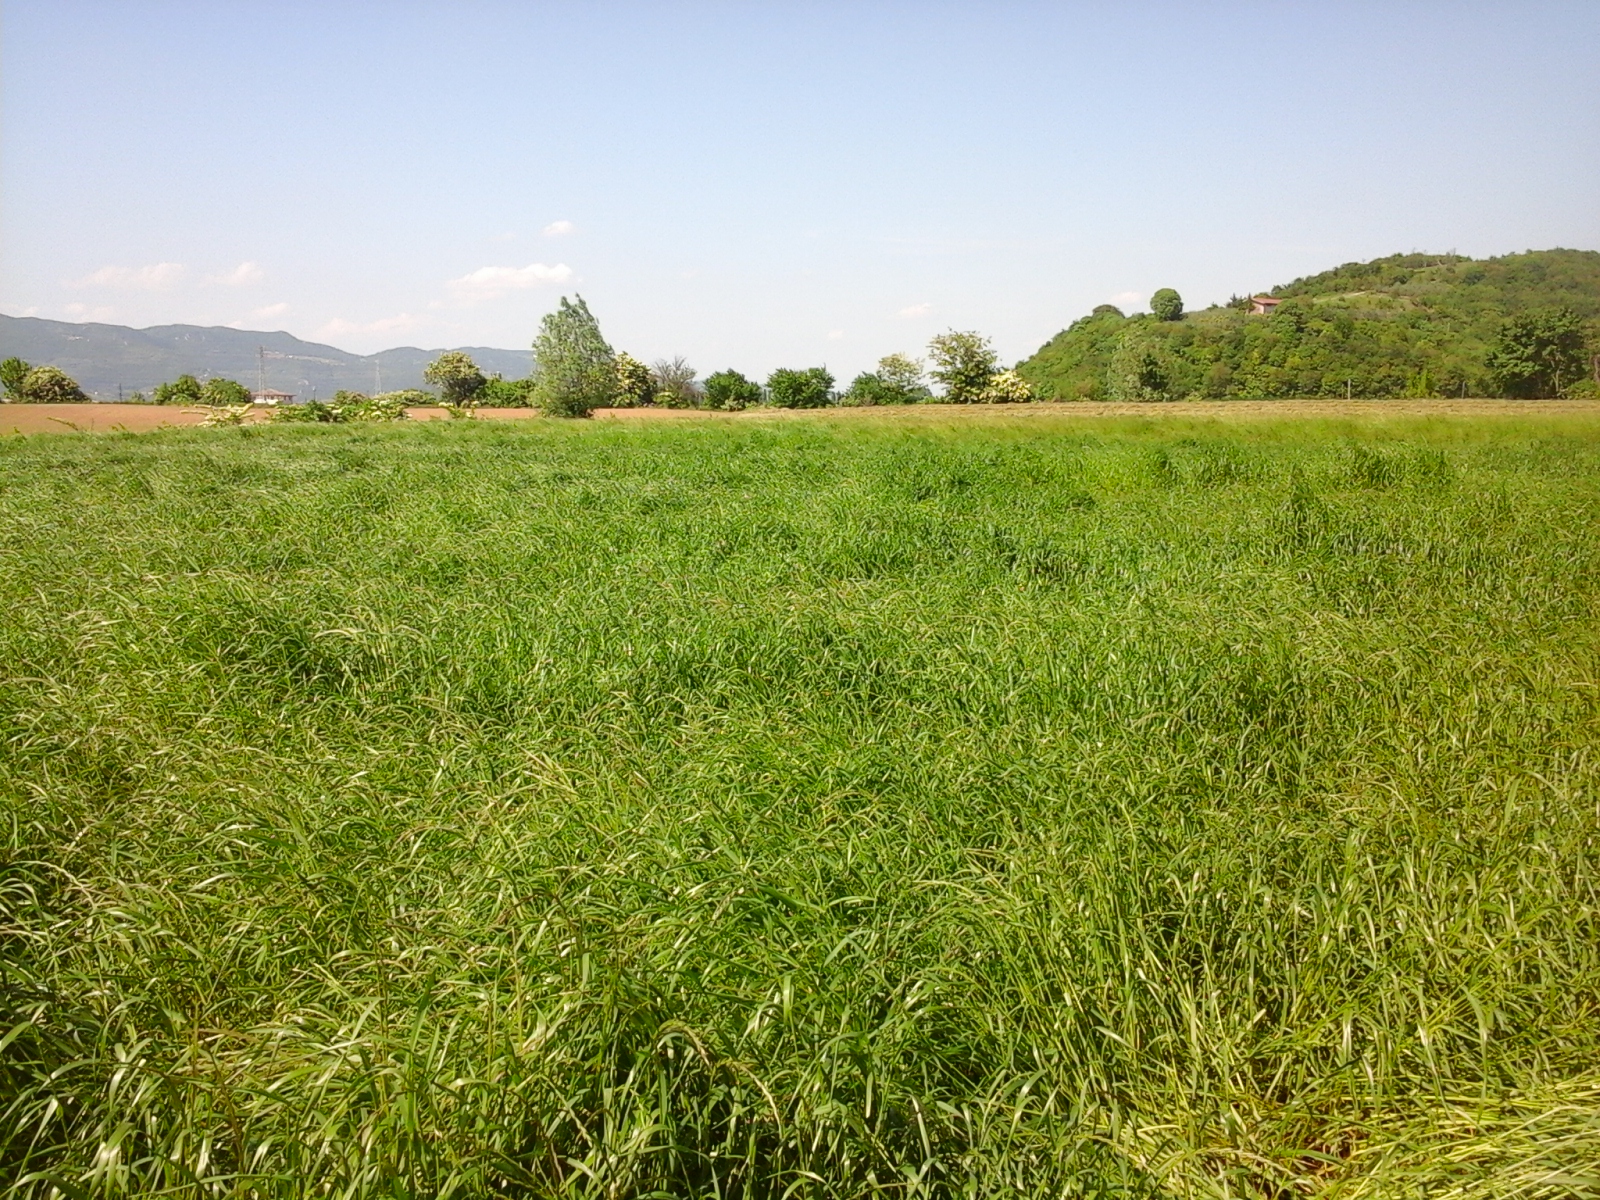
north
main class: Cropland
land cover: Temporary grasslands
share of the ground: > 75 %
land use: Agriculture (excluding fallow land and kitchen gardens)
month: May
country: IT
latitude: 45.3666
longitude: 11.5677
